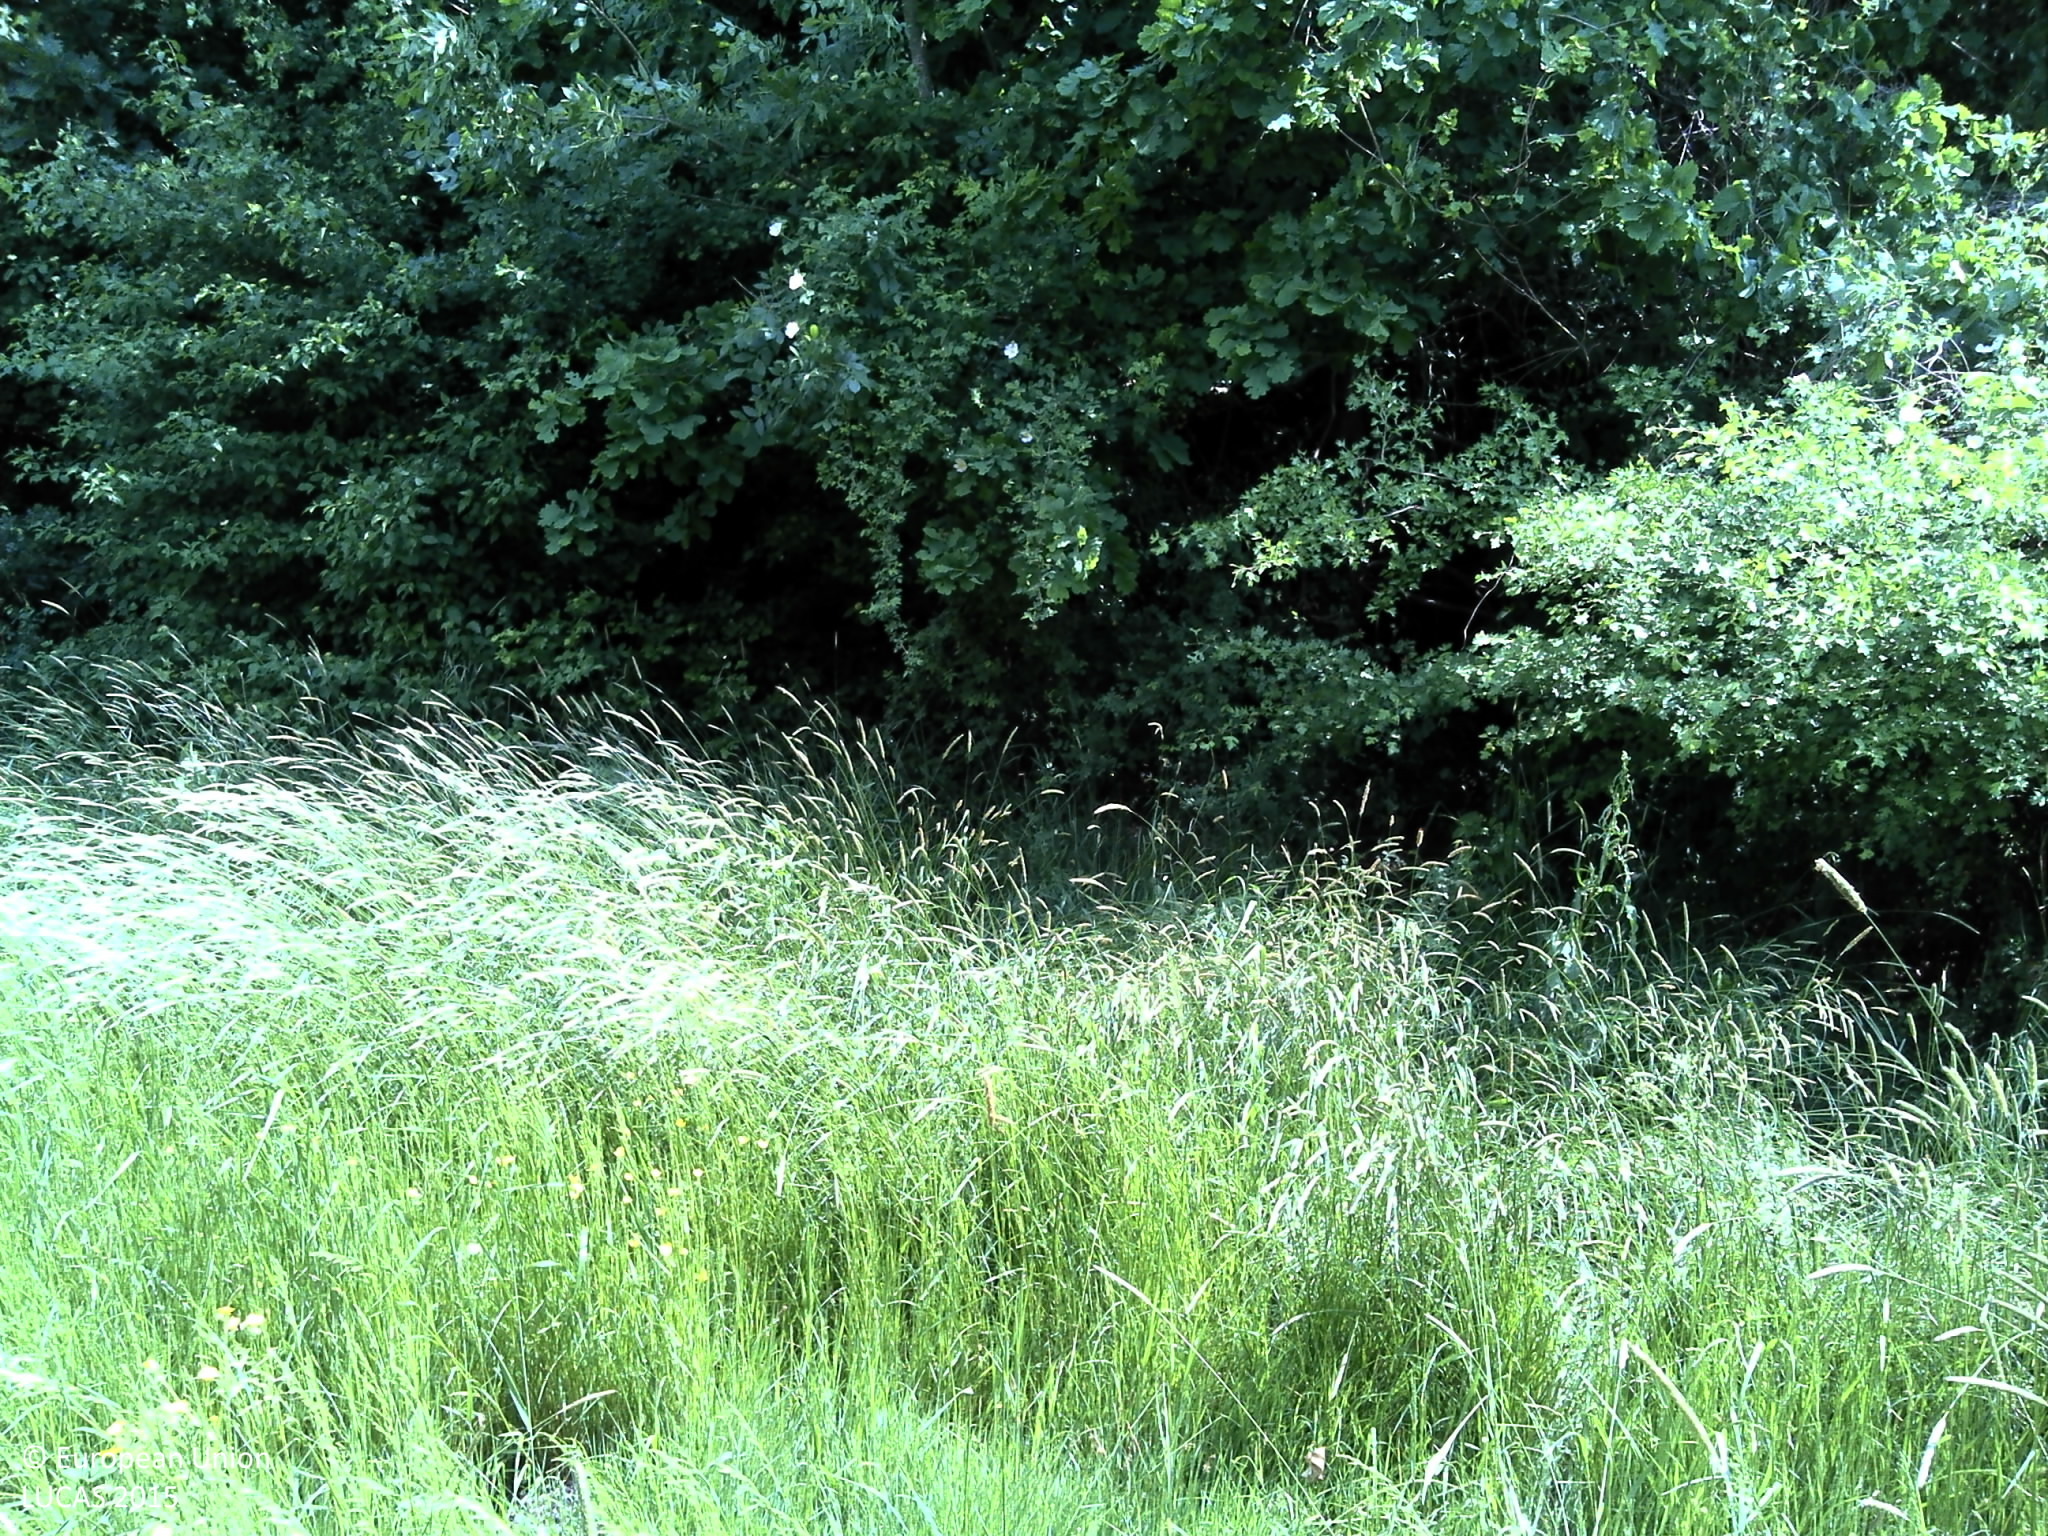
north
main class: Shrubland
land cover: Shrubland with sparse tree cover
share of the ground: > 75 %
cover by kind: shrubs 95 %, broadleaved forest trees 5 %
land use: Forestry
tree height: > 5 m
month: May
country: HR
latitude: 45.6236
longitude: 18.1493
